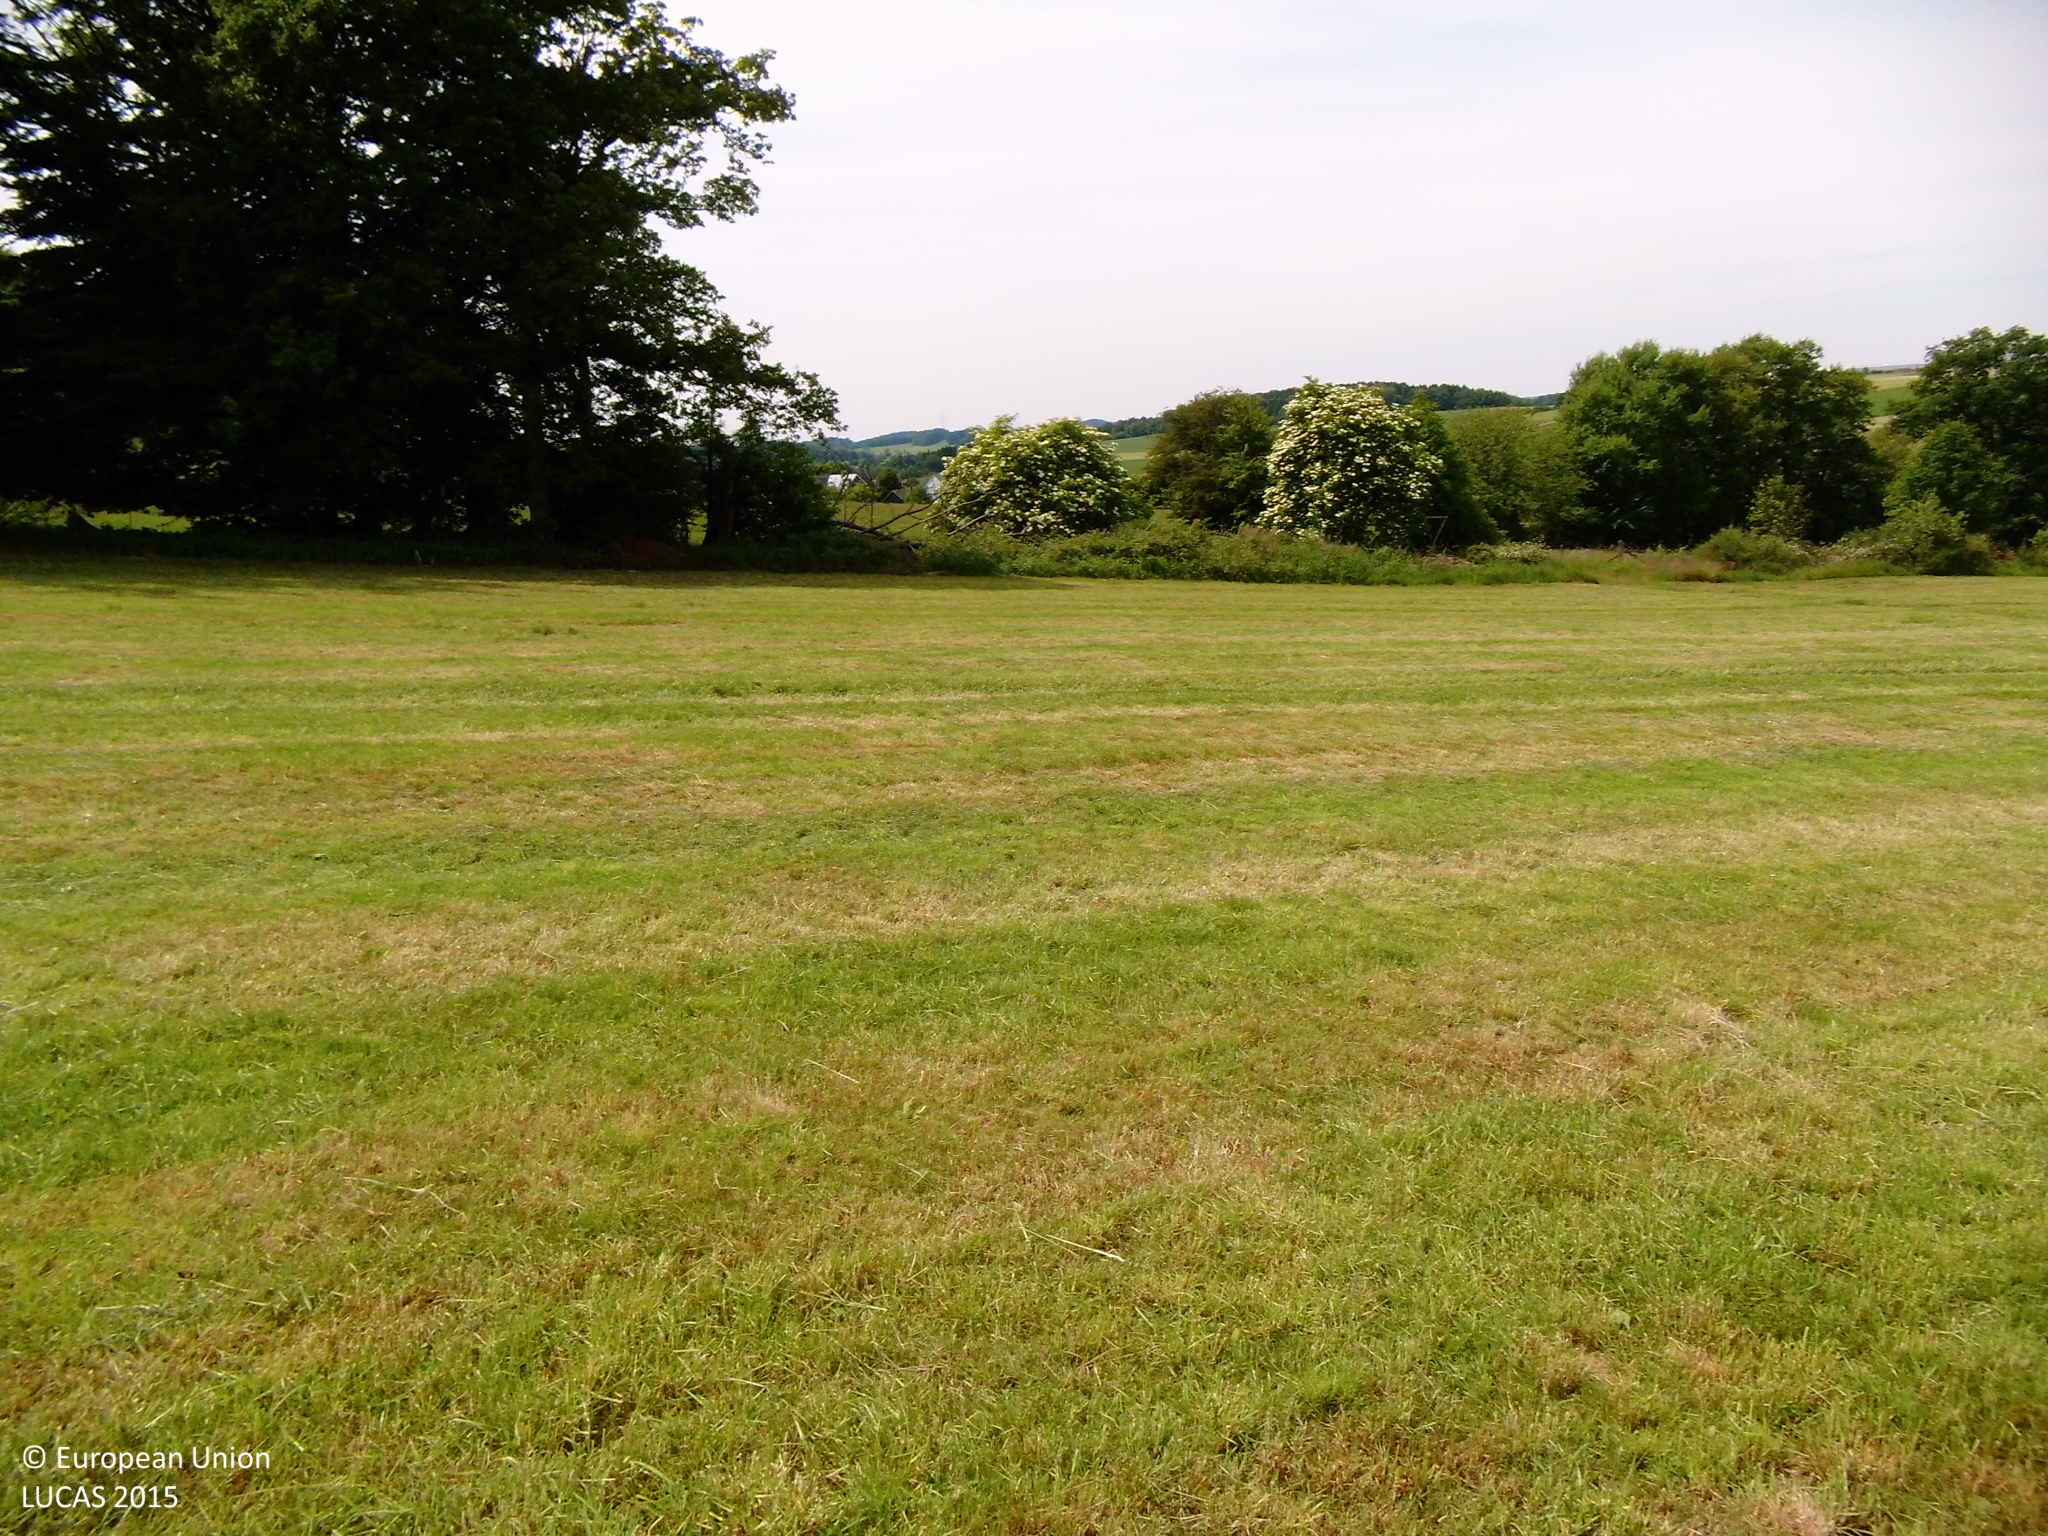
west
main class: Grassland
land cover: Grassland without tree/shrub cover
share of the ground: > 75 %
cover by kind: herbaceous plants 100 %
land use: Agriculture (excluding fallow land and kitchen gardens)
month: June
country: DE
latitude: 51.1090
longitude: 7.4435
